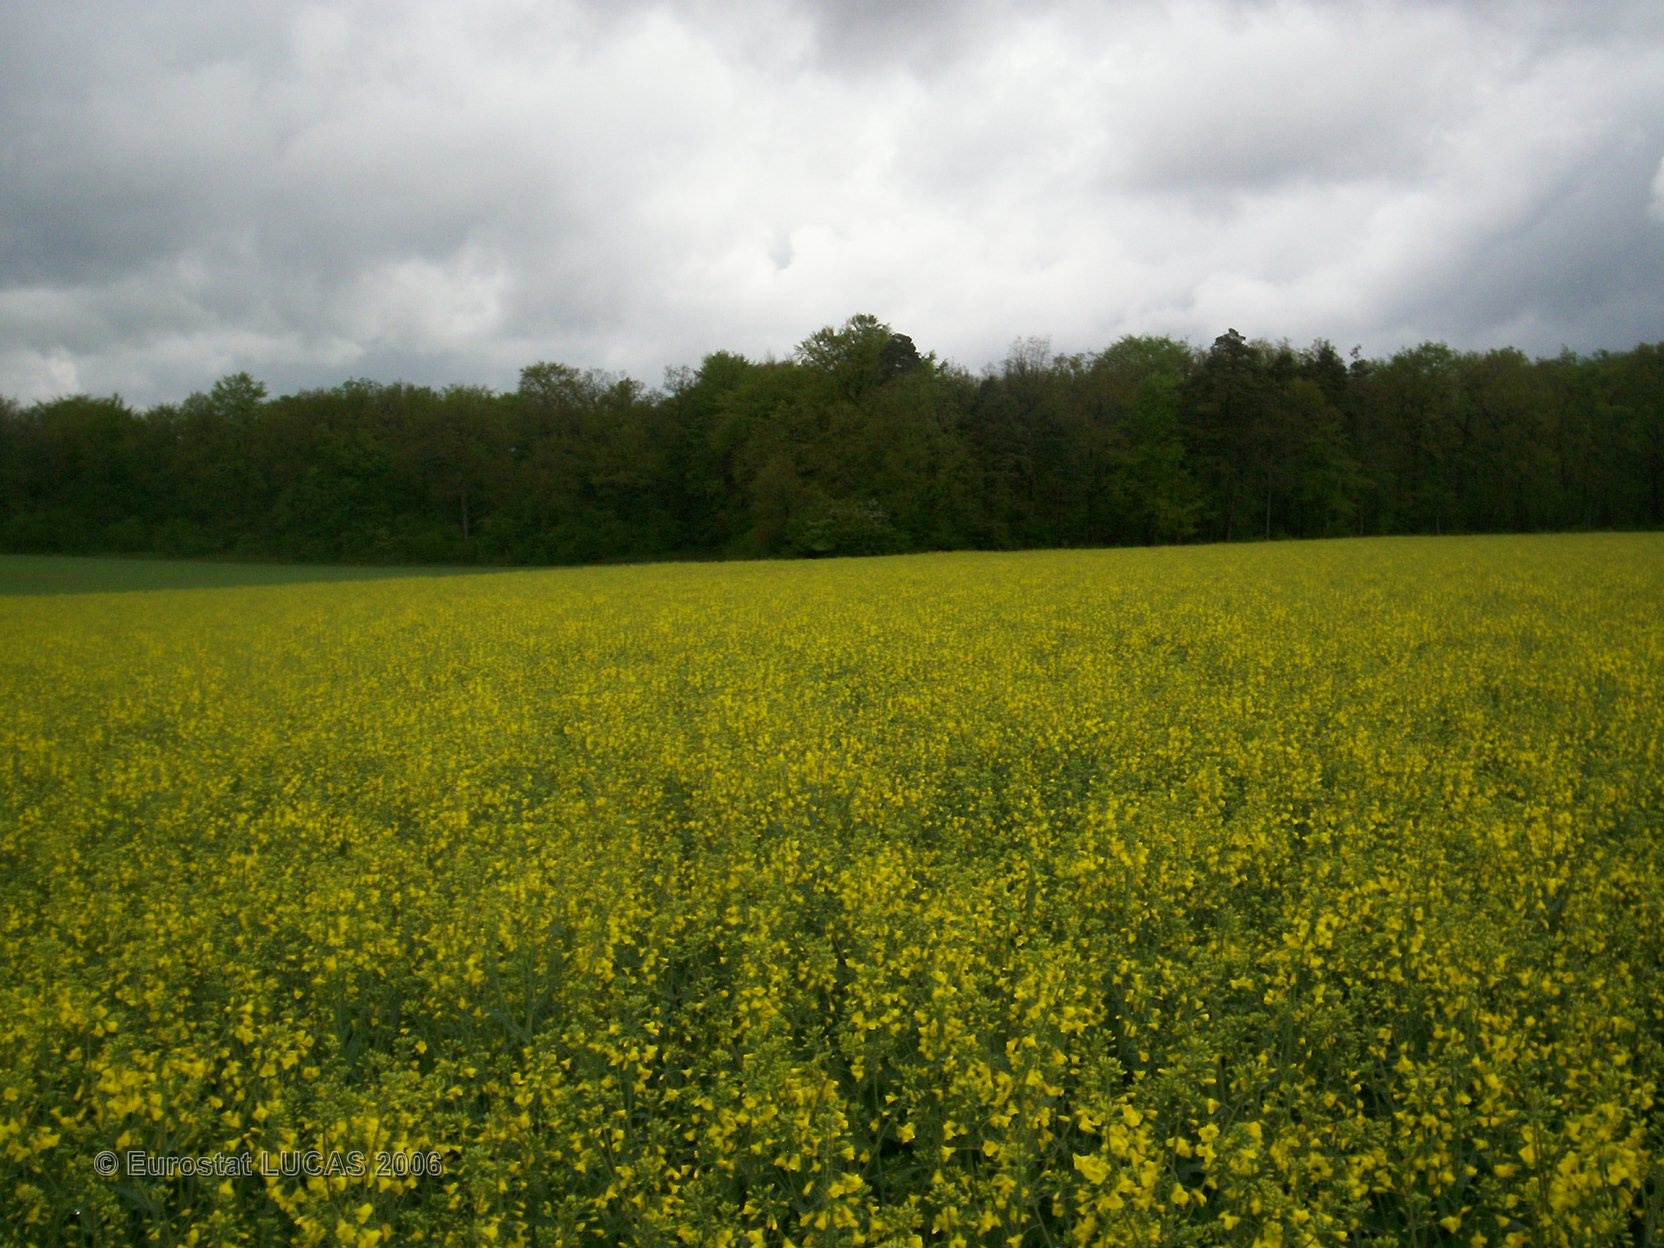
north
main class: Cropland
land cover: Rape and turnip rape
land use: Agriculture (excluding fallow land and kitchen gardens)
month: May
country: FR
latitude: 47.7843
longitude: 4.5931
